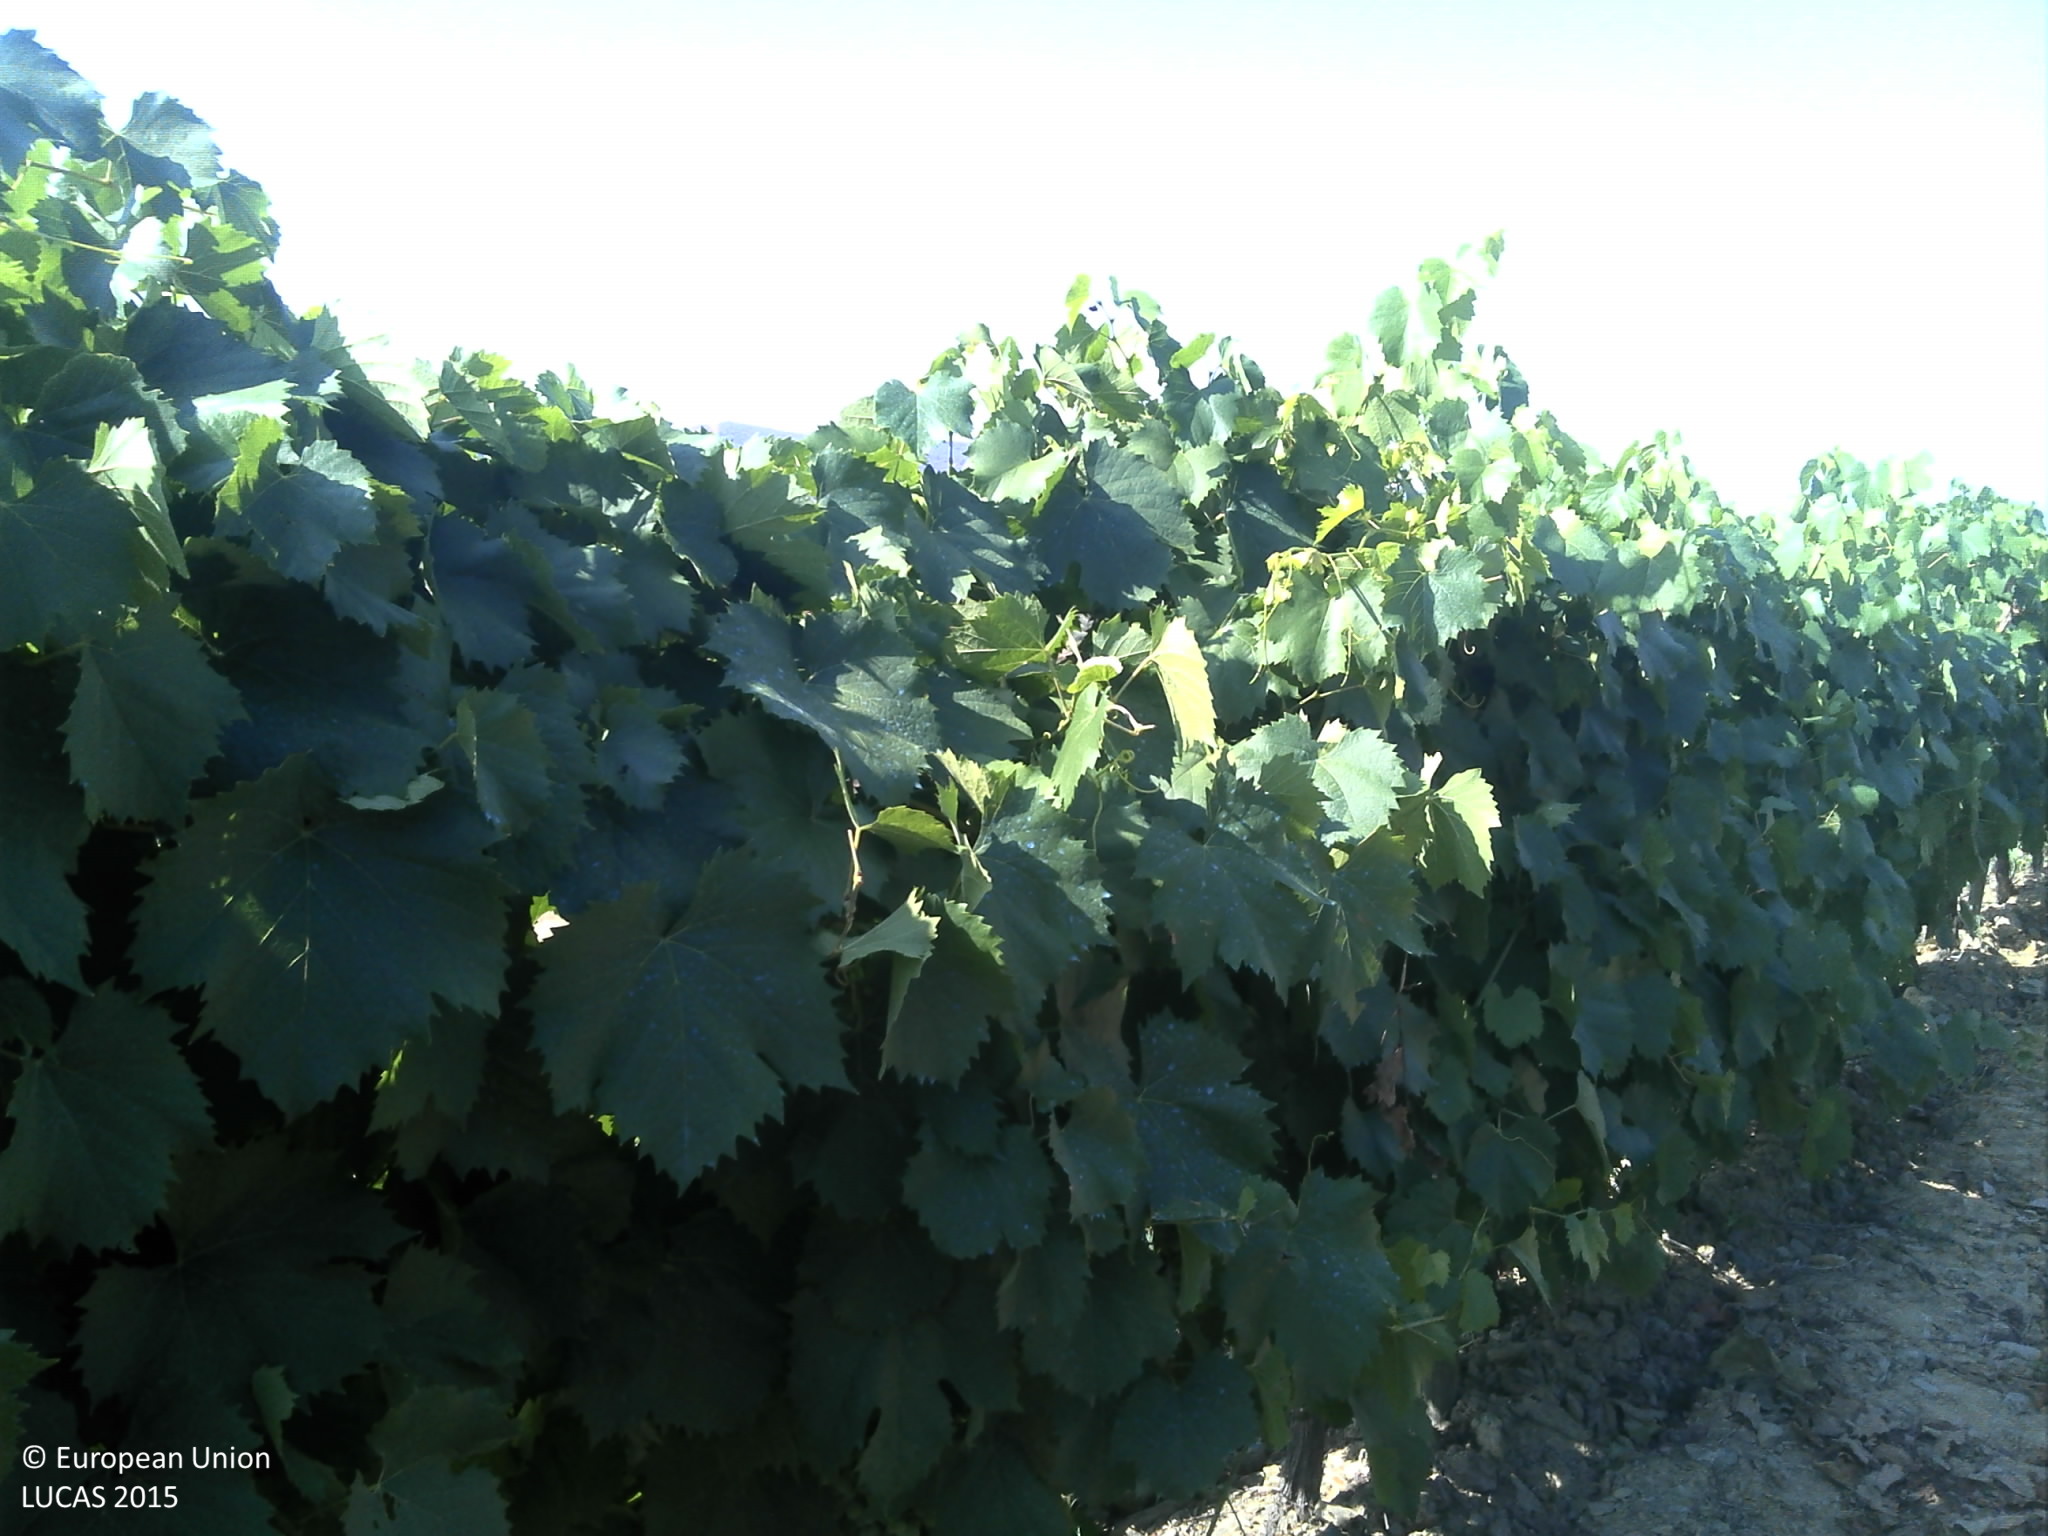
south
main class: Cropland
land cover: Vineyards
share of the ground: 25 - 50 %
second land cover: Grassland without tree/shrub cover
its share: 50 - 75 %
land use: Agriculture (excluding fallow land and kitchen gardens)
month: June
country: PT
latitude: 41.1909
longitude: -7.0781
